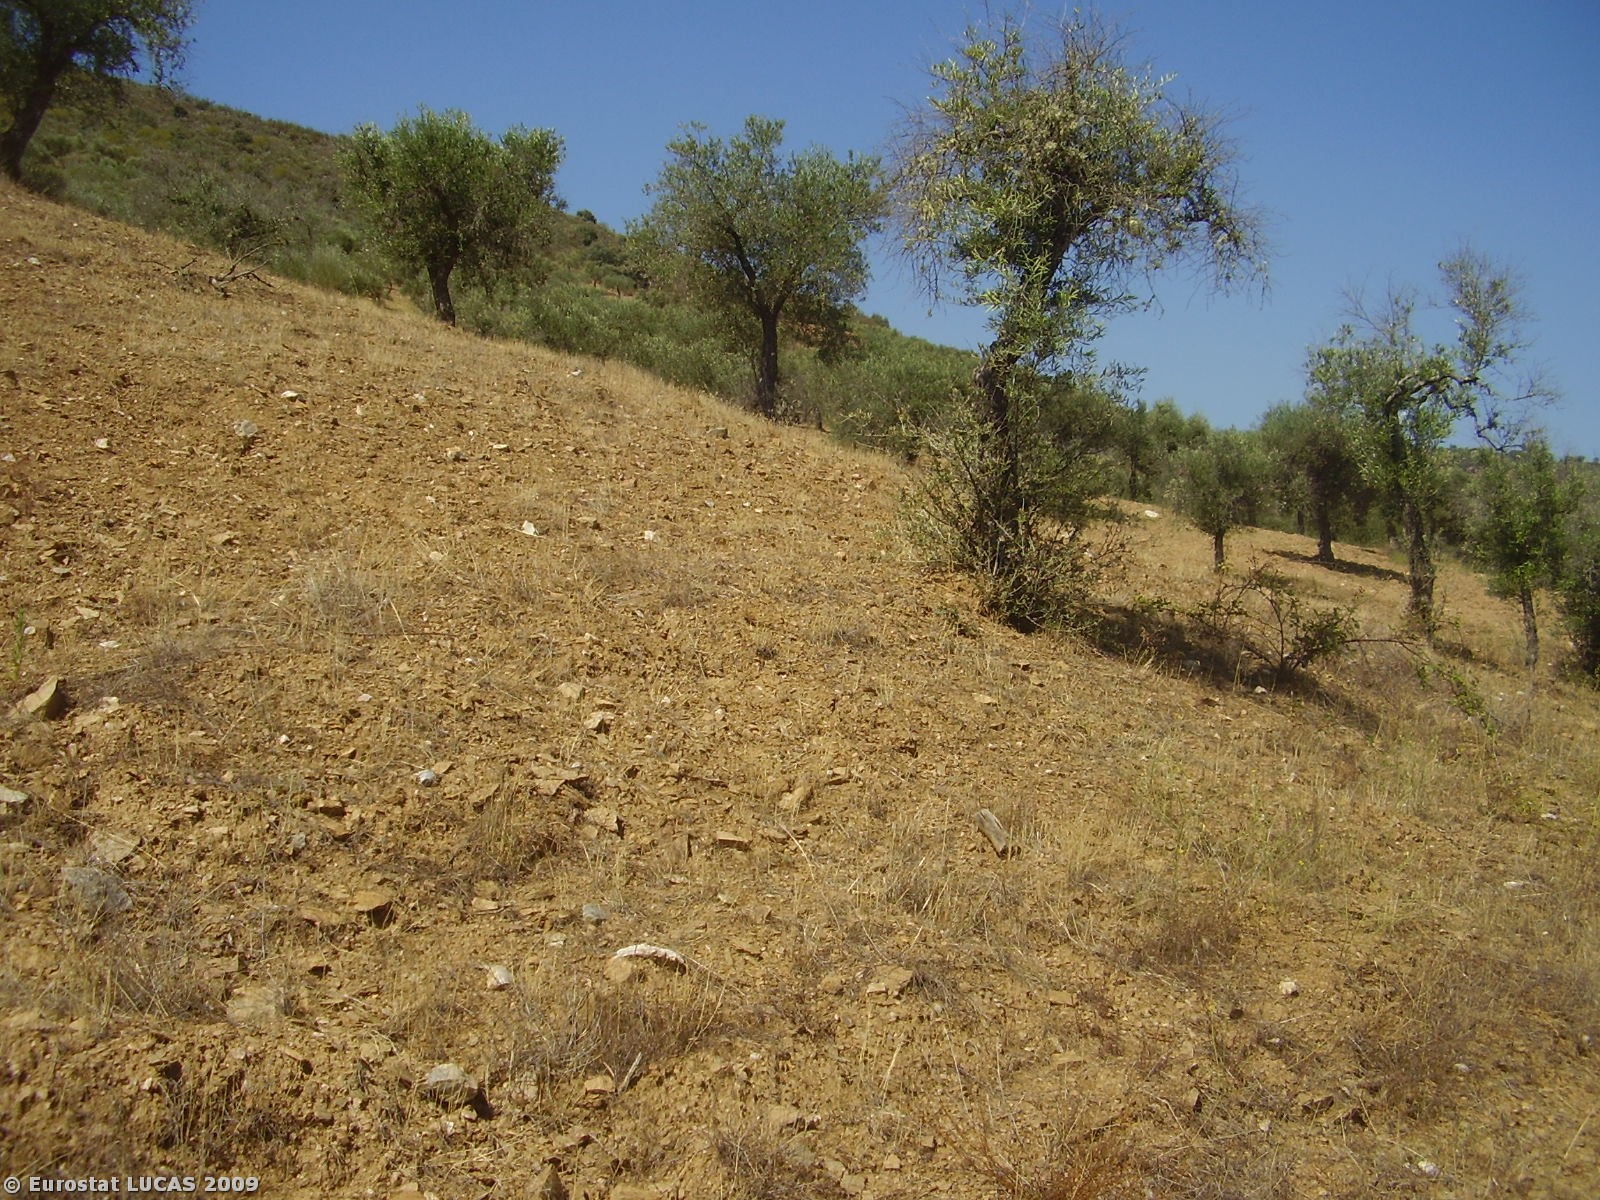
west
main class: Cropland
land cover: Olive groves
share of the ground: 10 - 25 %
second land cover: Spontaneously vegetated surfaces
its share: < 10 %
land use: Agriculture (excluding fallow land and kitchen gardens)
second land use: Fallow land
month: August
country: PT
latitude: 41.4366
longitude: -6.8285
